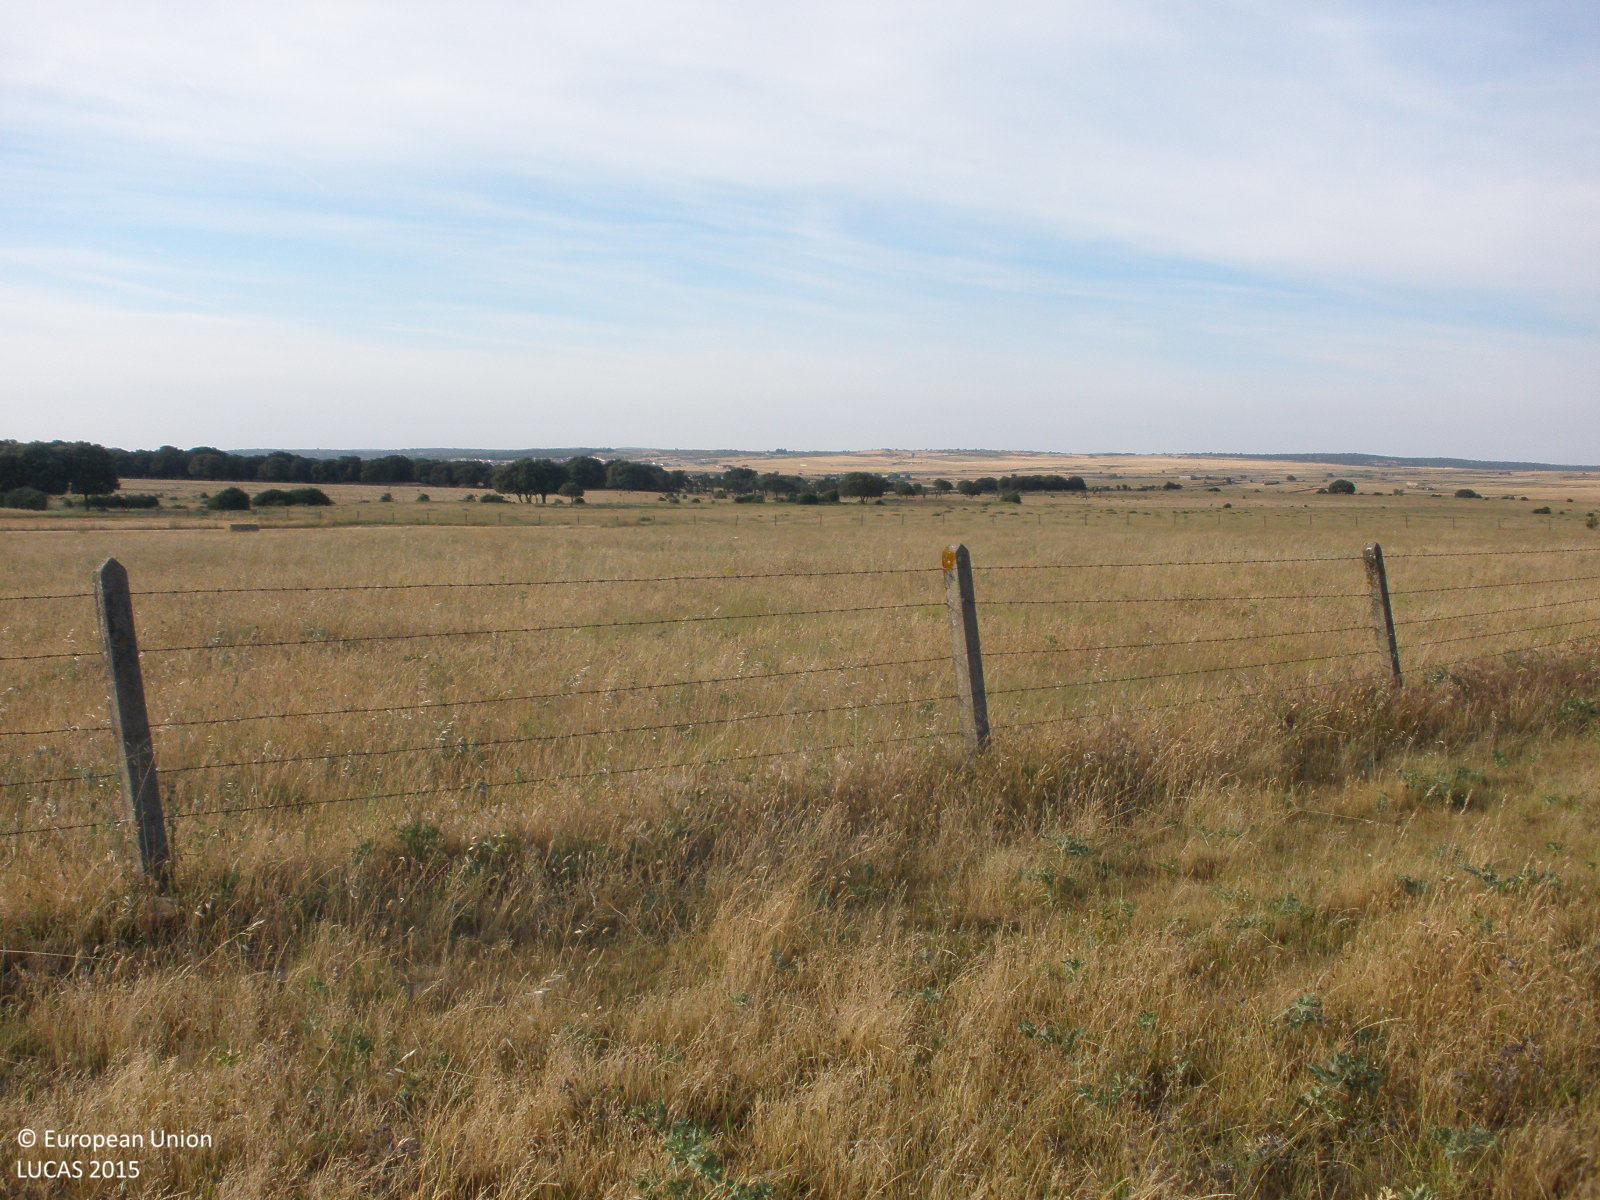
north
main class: Grassland
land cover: Grassland without tree/shrub cover
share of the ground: > 75 %
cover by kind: herbaceous plants 100 %
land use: Agriculture (excluding fallow land and kitchen gardens)
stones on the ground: 10 - 25 %
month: June
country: ES
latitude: 40.6957
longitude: -6.7469
